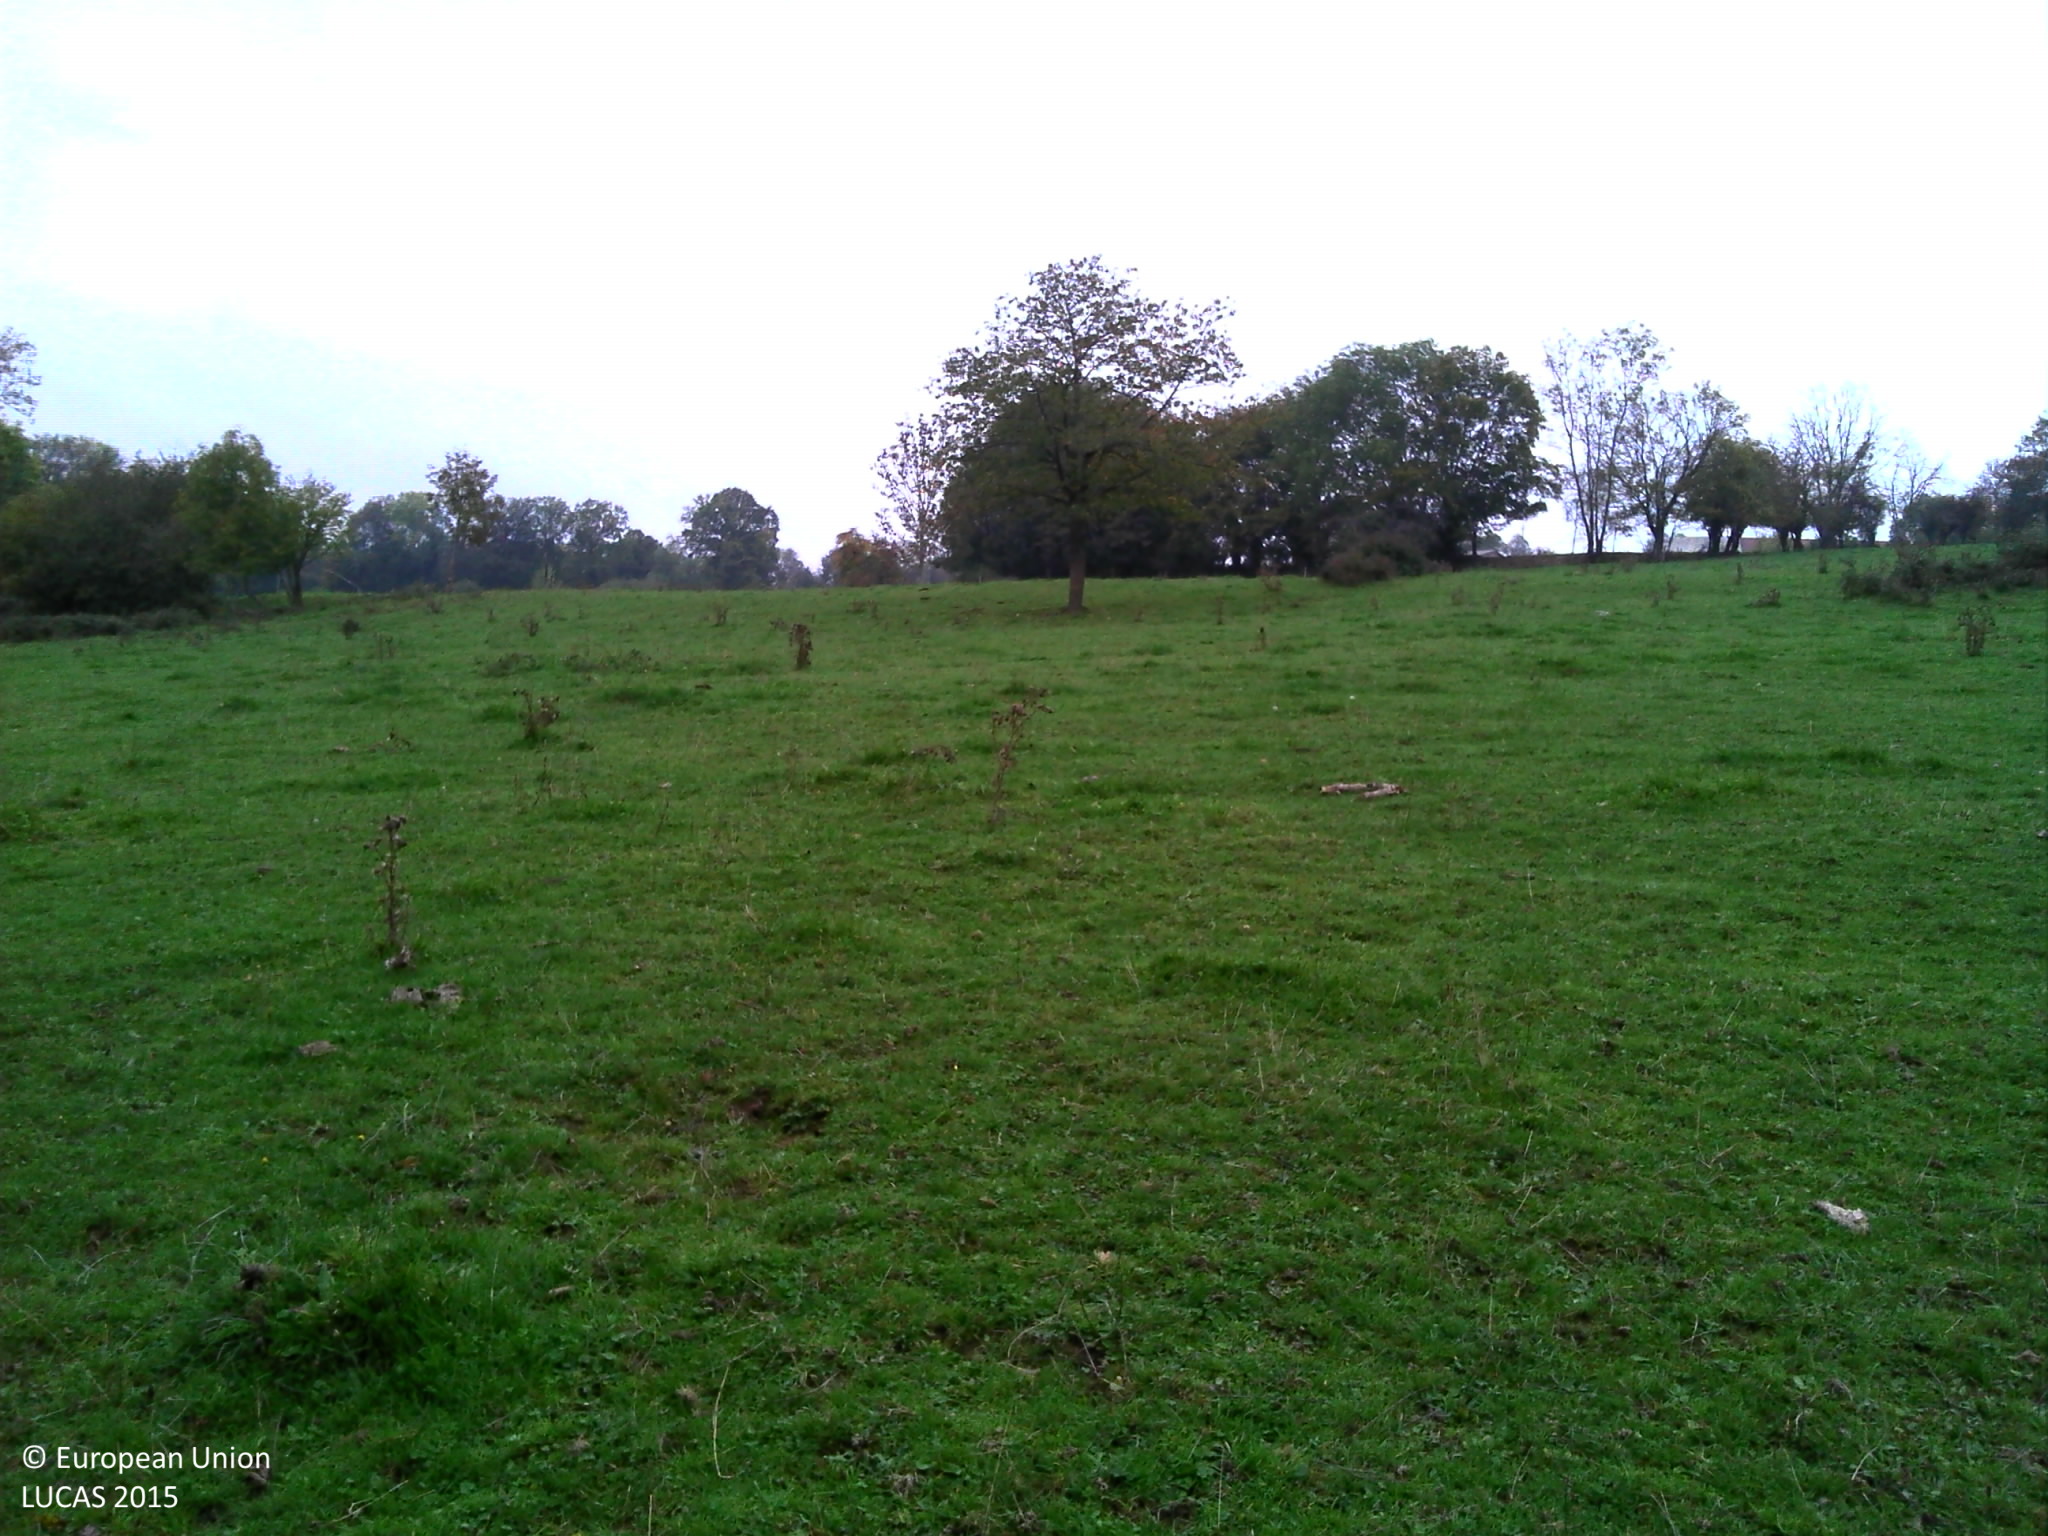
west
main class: Grassland
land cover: Grassland without tree/shrub cover
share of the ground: > 75 %
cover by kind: herbaceous plants 95 %, unconsolidated bare surface 5 %
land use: Agriculture (excluding fallow land and kitchen gardens)
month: October
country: FR
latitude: 45.9978
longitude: 3.0393
